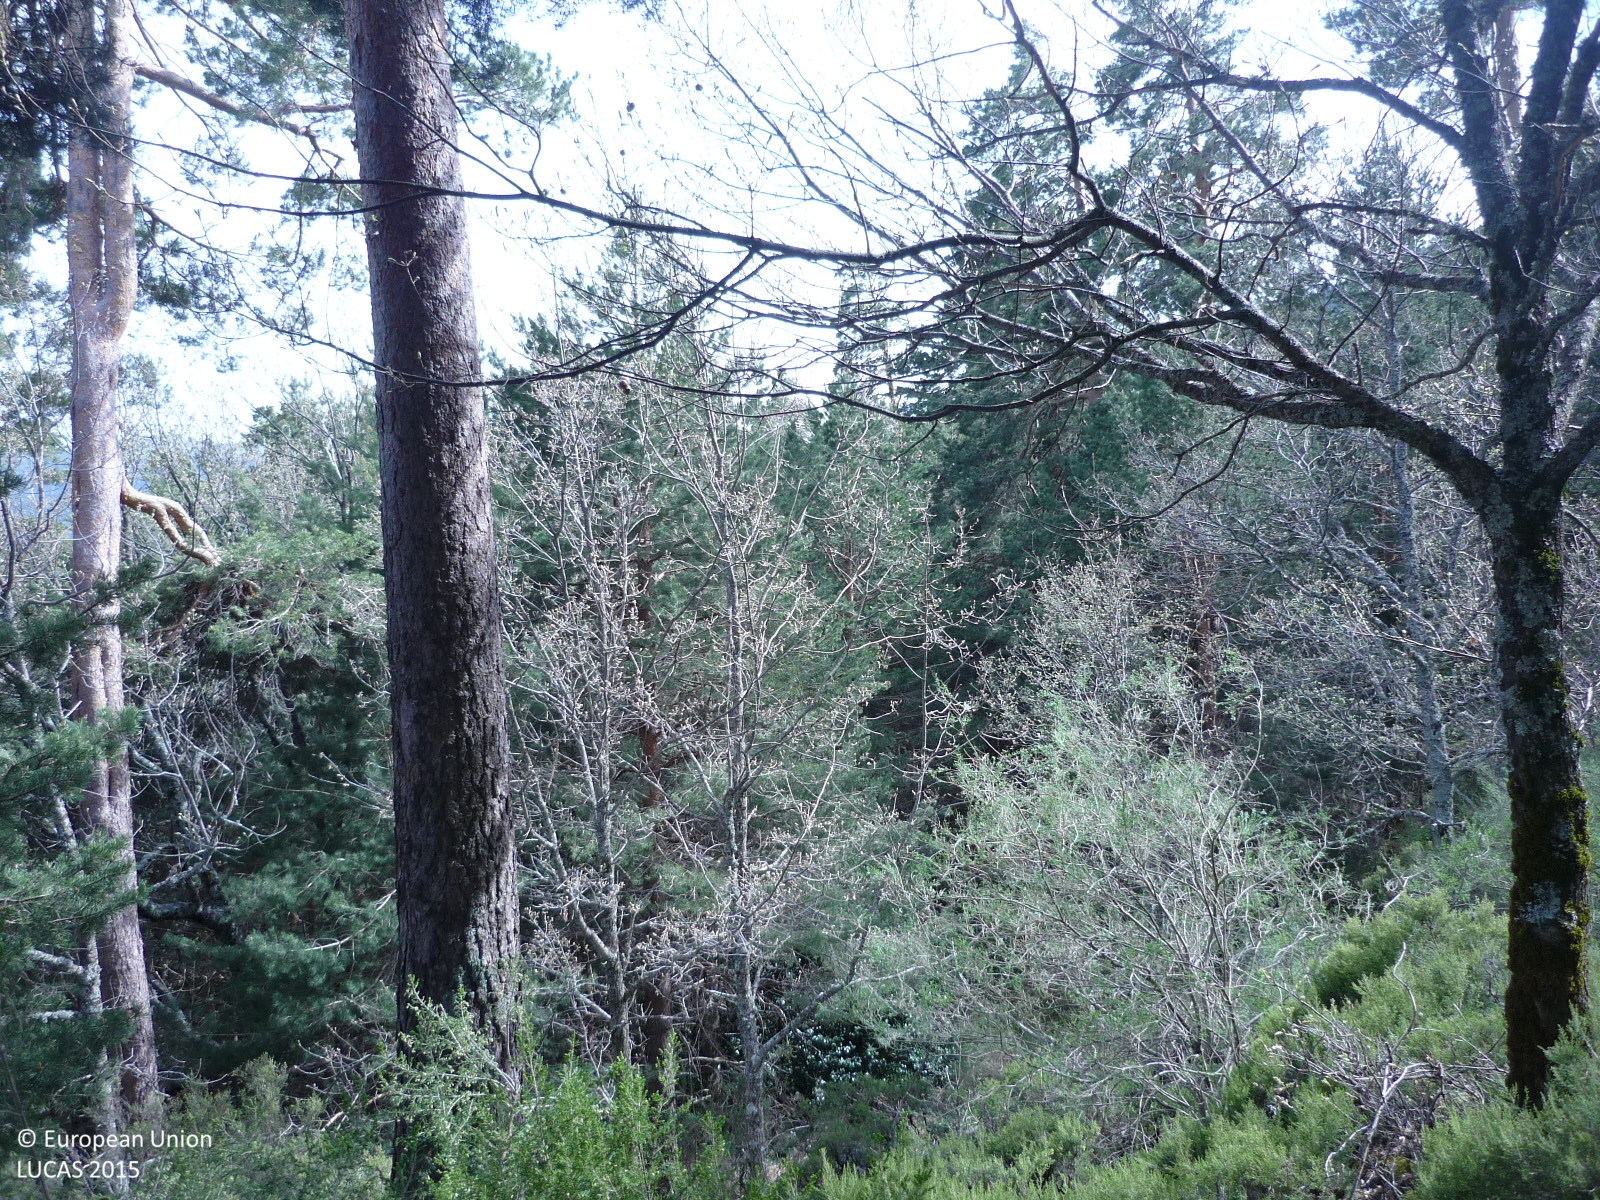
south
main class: Woodland
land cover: Pine dominated coniferous woodland
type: coniferous forest of the mediterranean region
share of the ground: > 75 %
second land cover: Grassland without tree/shrub cover
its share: 25 - 50 %
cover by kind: coniferous forest trees 85 %, shrubs 10 %, herbaceous plants 5 %
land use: Forestry
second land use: Agriculture (excluding fallow land and kitchen gardens)
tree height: > 5 m
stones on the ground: < 10 %
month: May
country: ES
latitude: 40.8821
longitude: -3.9195
